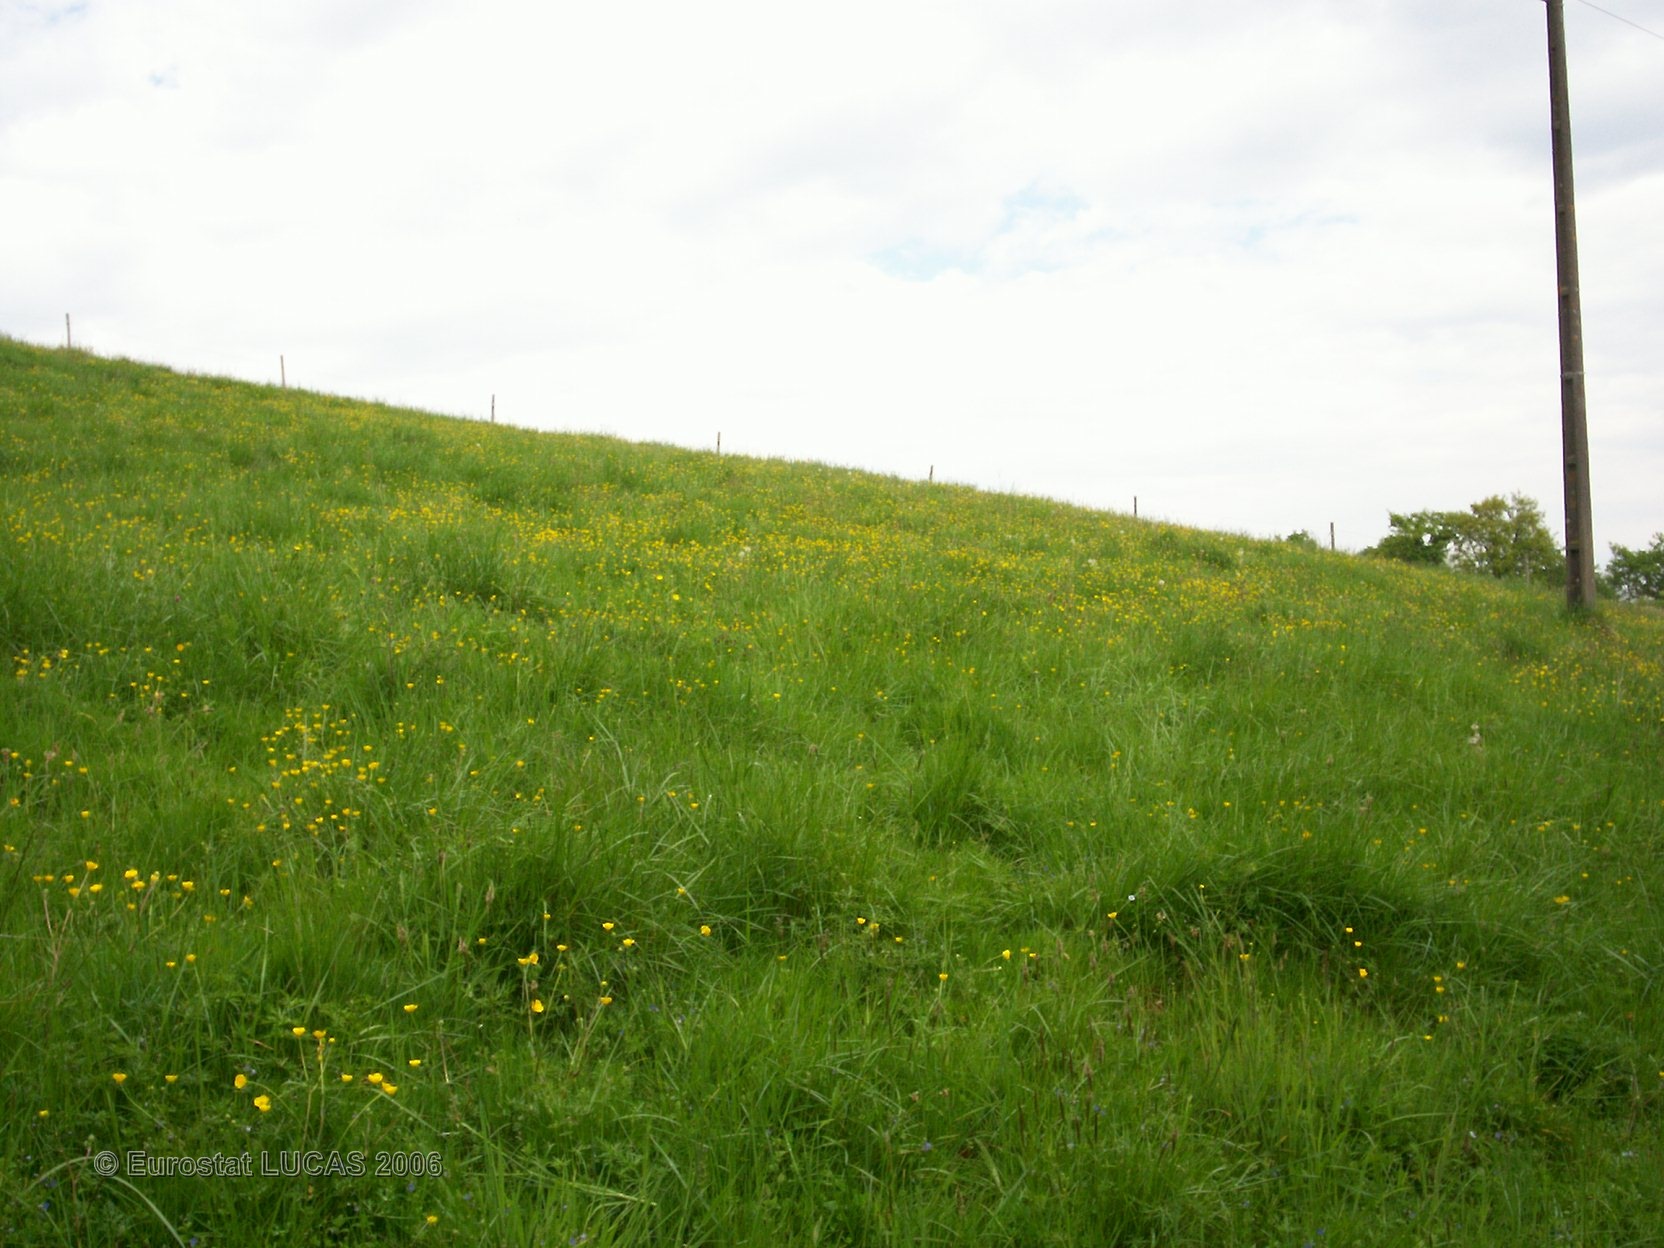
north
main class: Grassland
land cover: Grassland without tree/shrub cover
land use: Agriculture (excluding fallow land and kitchen gardens)
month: April
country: FR
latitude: 43.4911
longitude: -0.6573
